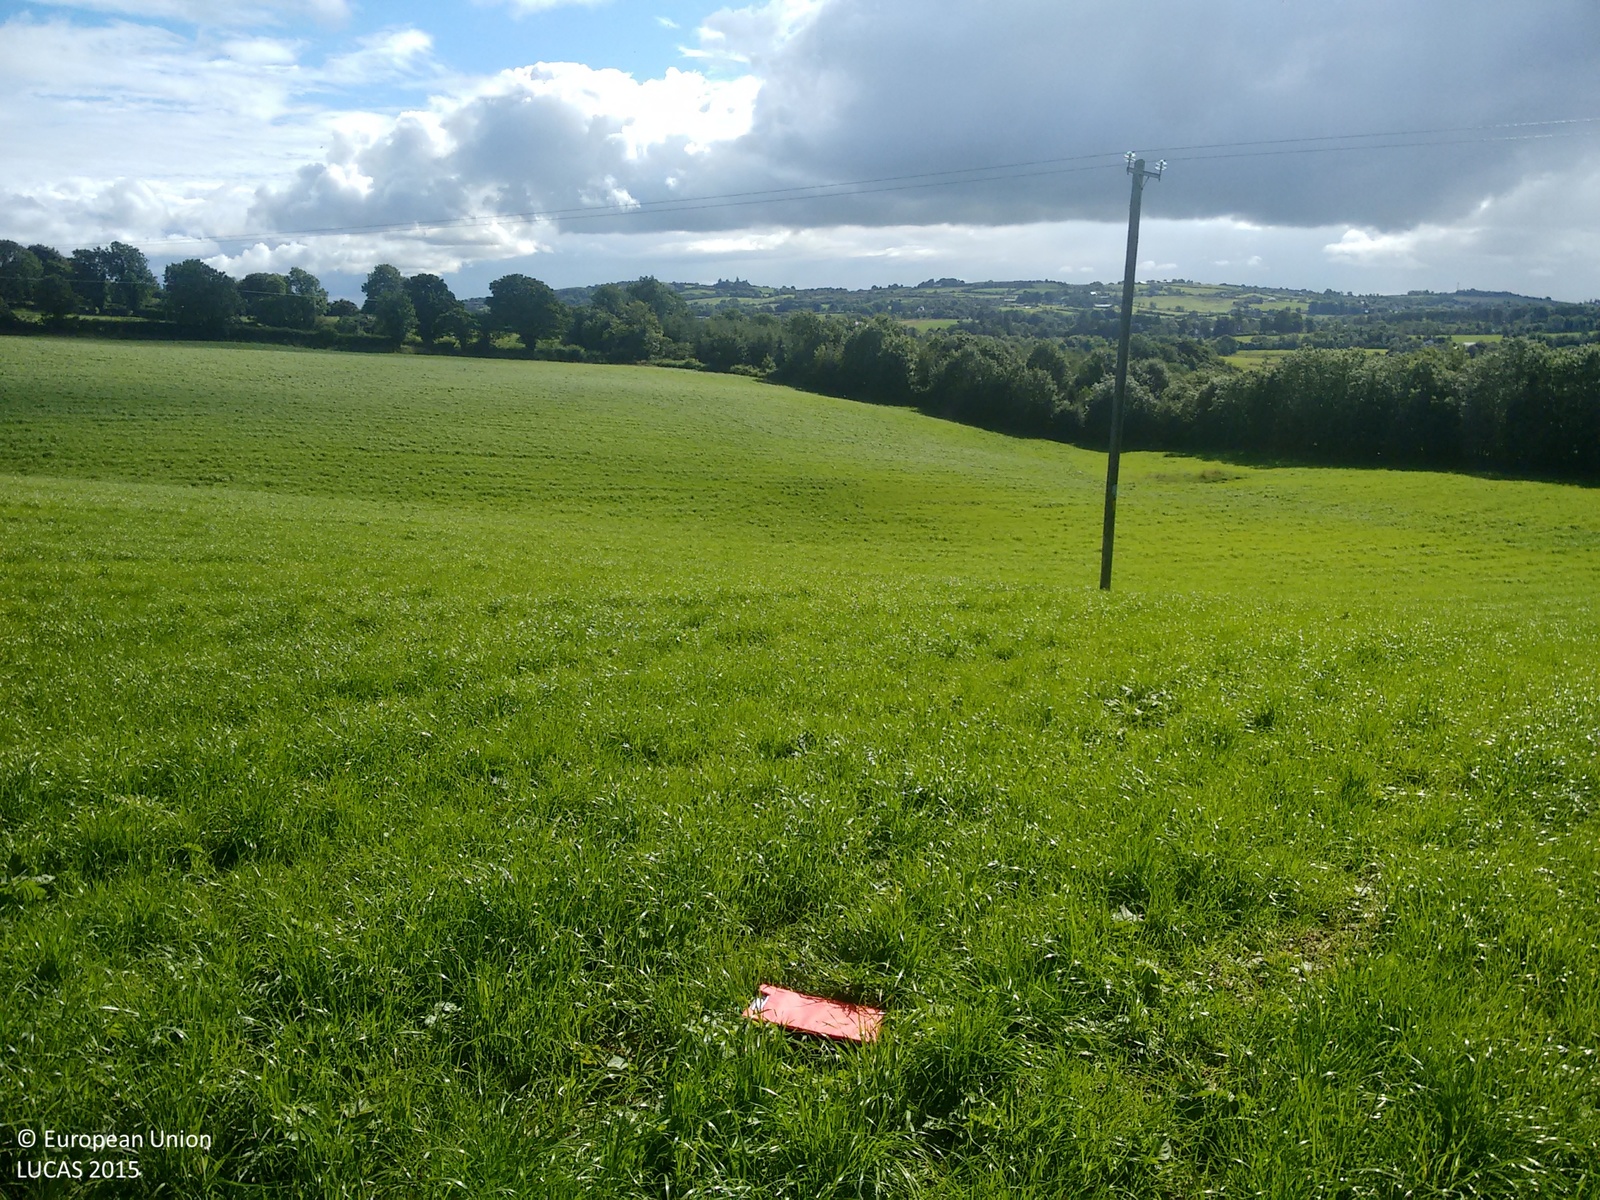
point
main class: Grassland
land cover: Grassland without tree/shrub cover
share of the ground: > 75 %
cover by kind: herbaceous plants 100 %
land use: Agriculture (excluding fallow land and kitchen gardens)
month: September
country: IE
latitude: 53.8965
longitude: -7.1440
